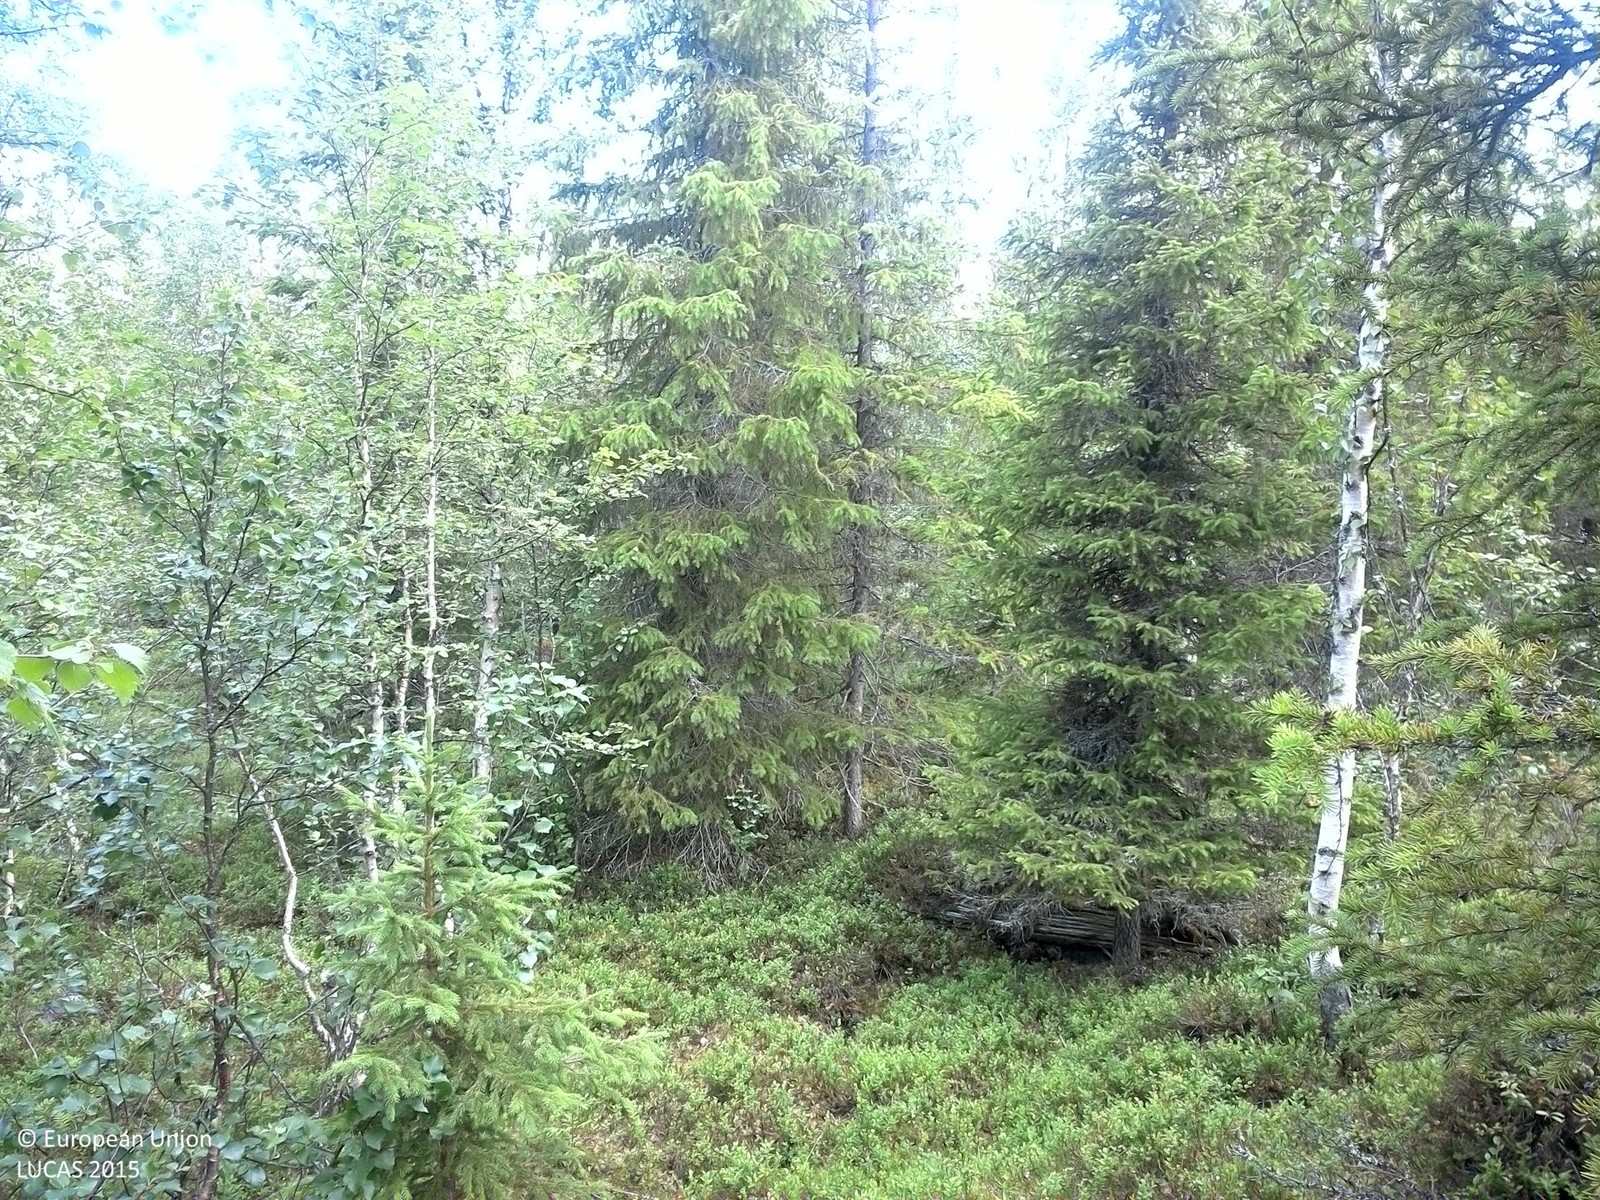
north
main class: Woodland
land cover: Other mixed woodland
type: boreal forest
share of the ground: 50 - 75 %
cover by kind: coniferous forest trees 30 %, shrubs 30 %, broadleaved forest trees 25 %, lichens and mosses 15 %
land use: Forestry
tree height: > 5 m
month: July
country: SE
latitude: 64.7168
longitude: 15.5717
